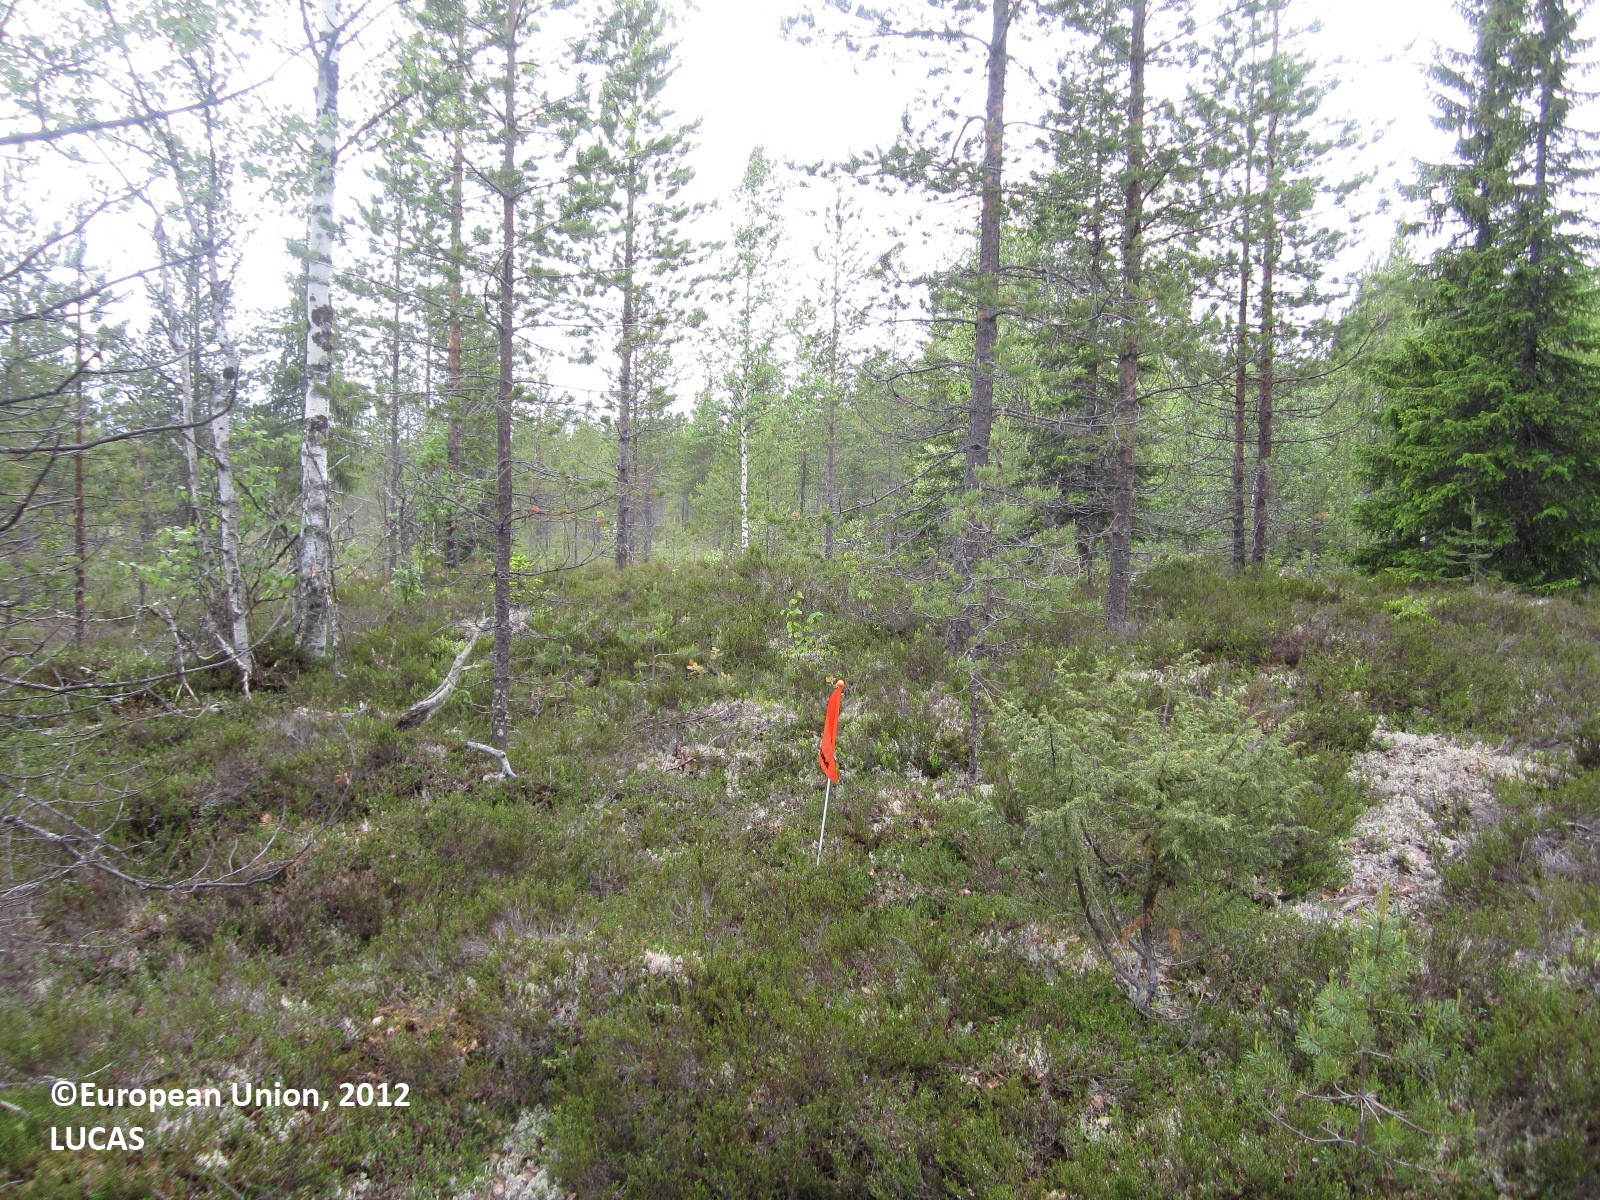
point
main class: Woodland
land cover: Pine dominated coniferous woodland
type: boreal forest
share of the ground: 25 - 50 %
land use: Forestry
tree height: > 5 m
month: June
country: FI
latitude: 64.3964
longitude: 29.5681
